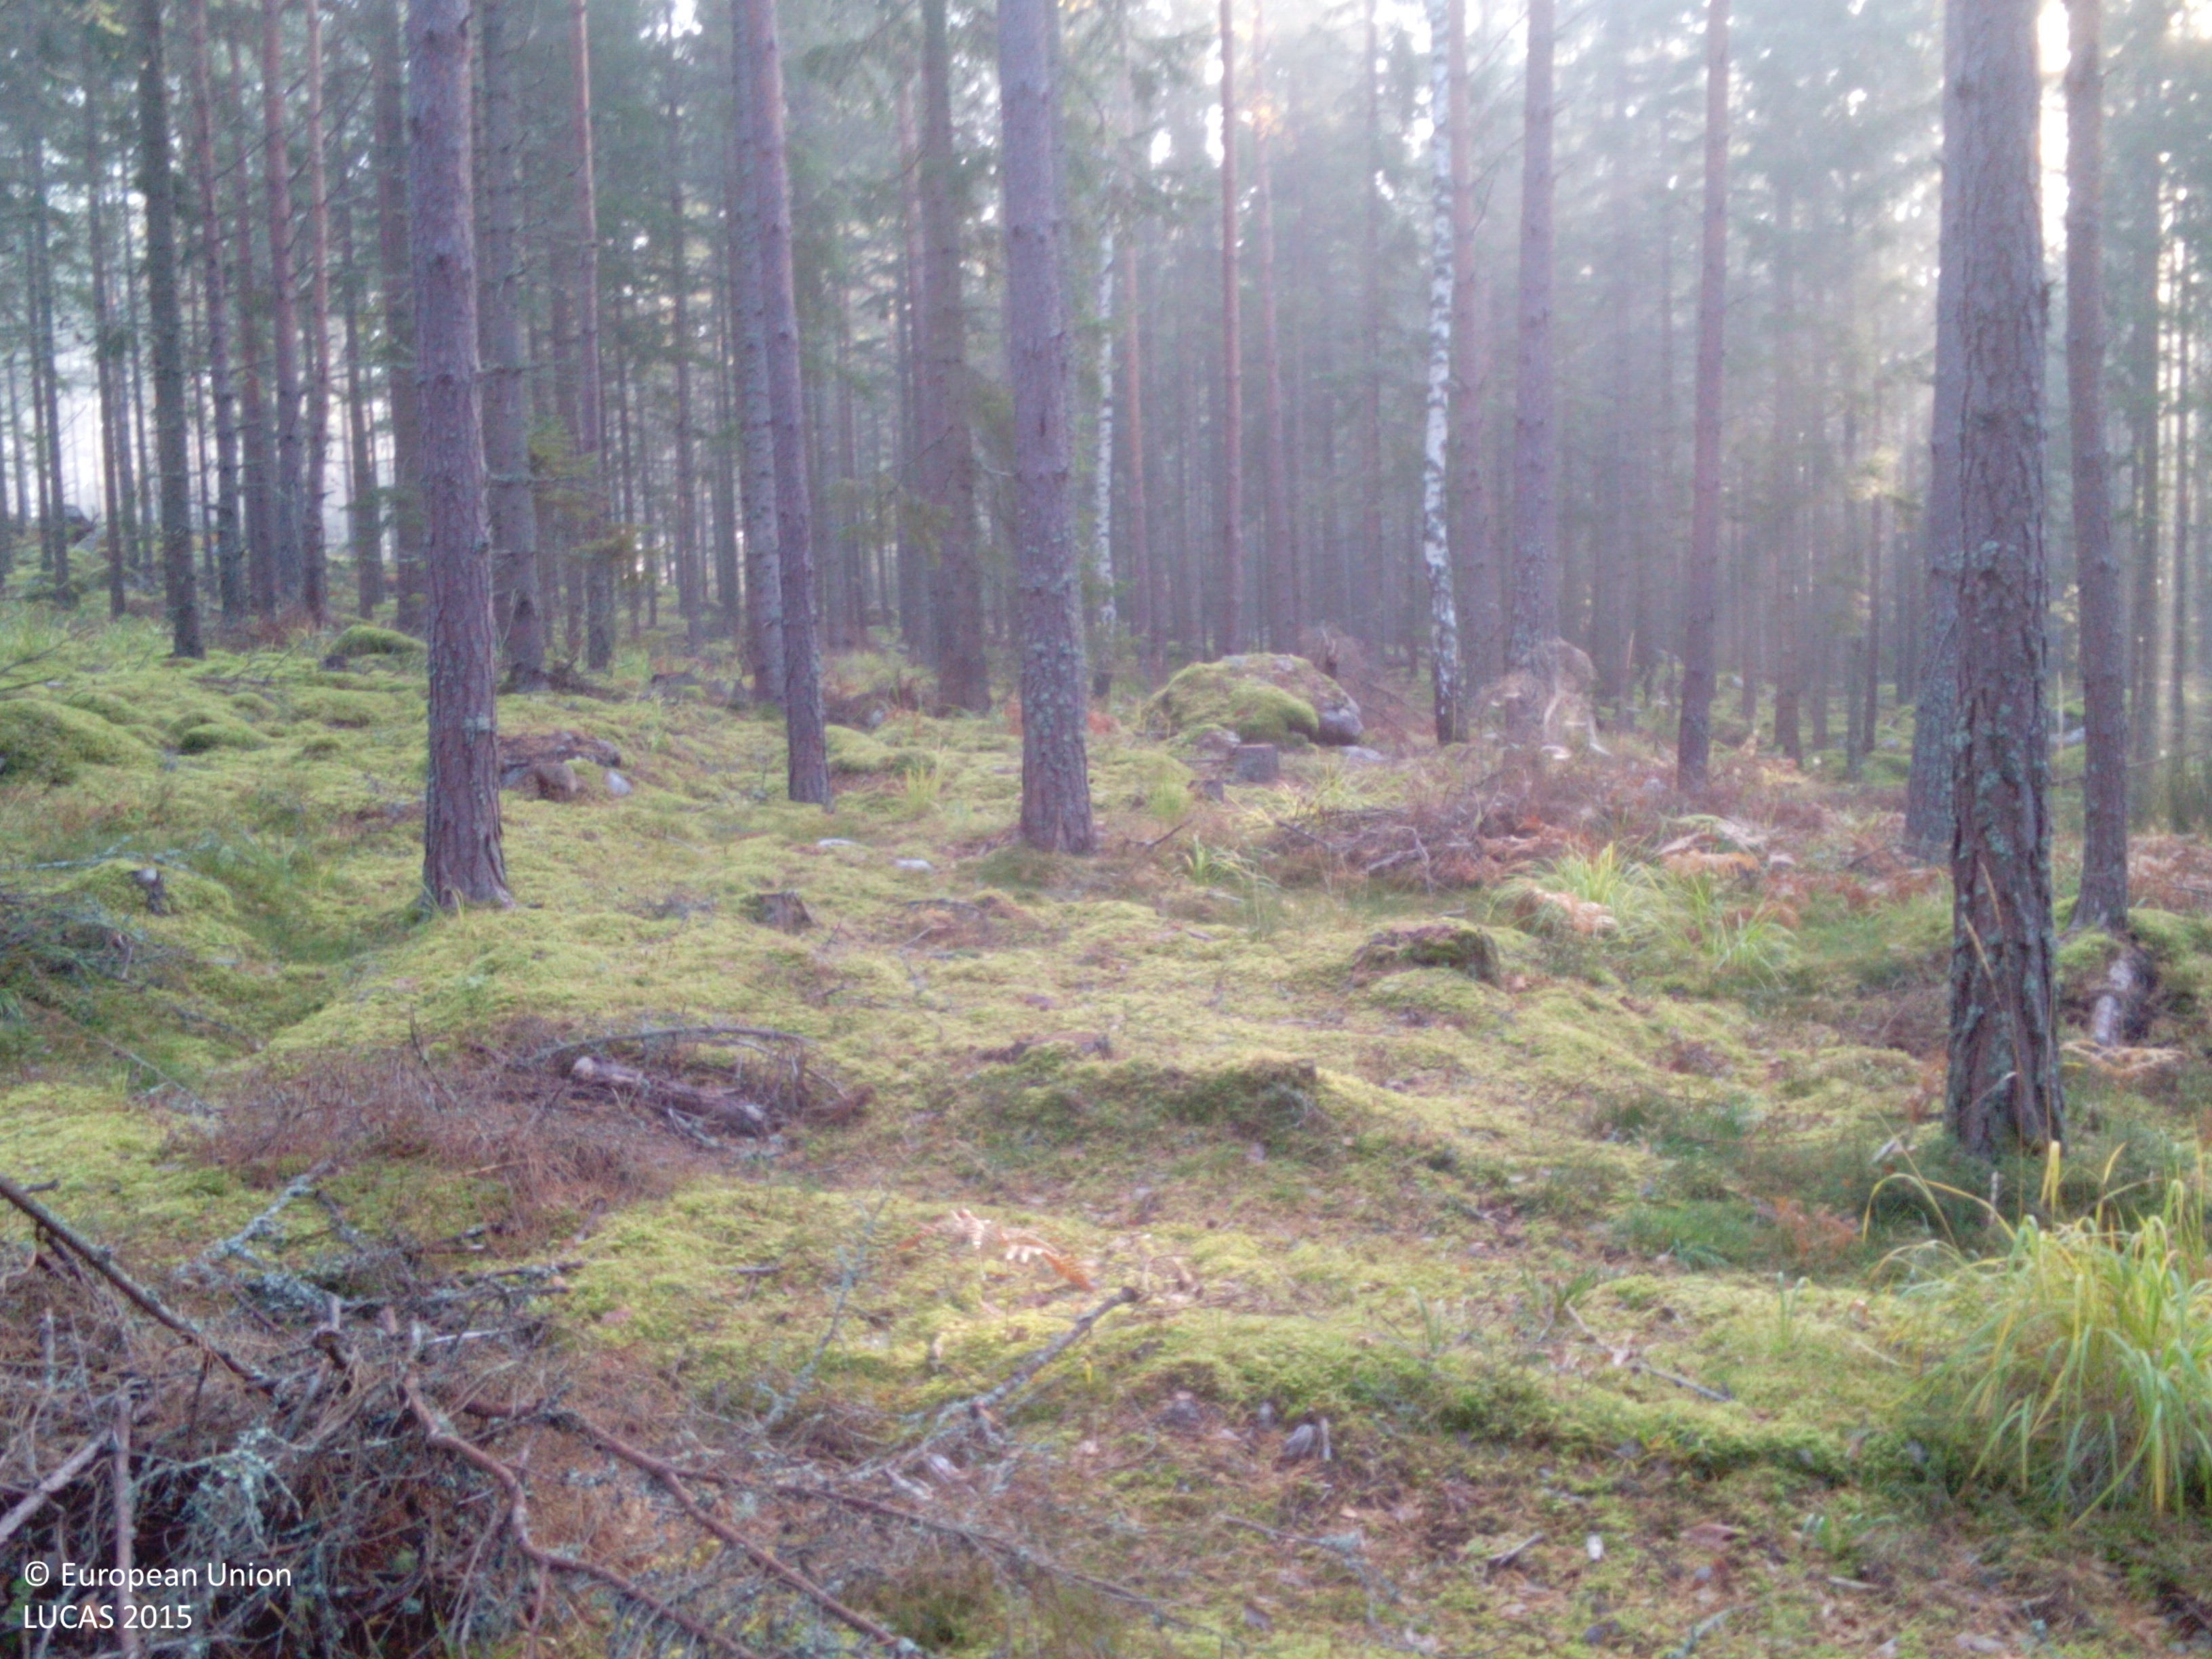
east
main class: Woodland
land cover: Other coniferous woodland
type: boreal forest
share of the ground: > 75 %
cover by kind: coniferous forest trees 85 %, lichens and mosses 10 %, herbaceous plants 5 %
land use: Forestry
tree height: > 5 m
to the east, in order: Other coniferous woodland; Spruce dominated coniferous woodland; Pine dominated coniferous woodland; Other coniferous woodland; Ditches and canals; Paved roads, cycling and walking lanes; Spontaneously vegetated surfaces; Spruce dominated coniferous woodland
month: October
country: SE
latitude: 58.8292
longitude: 16.3169
